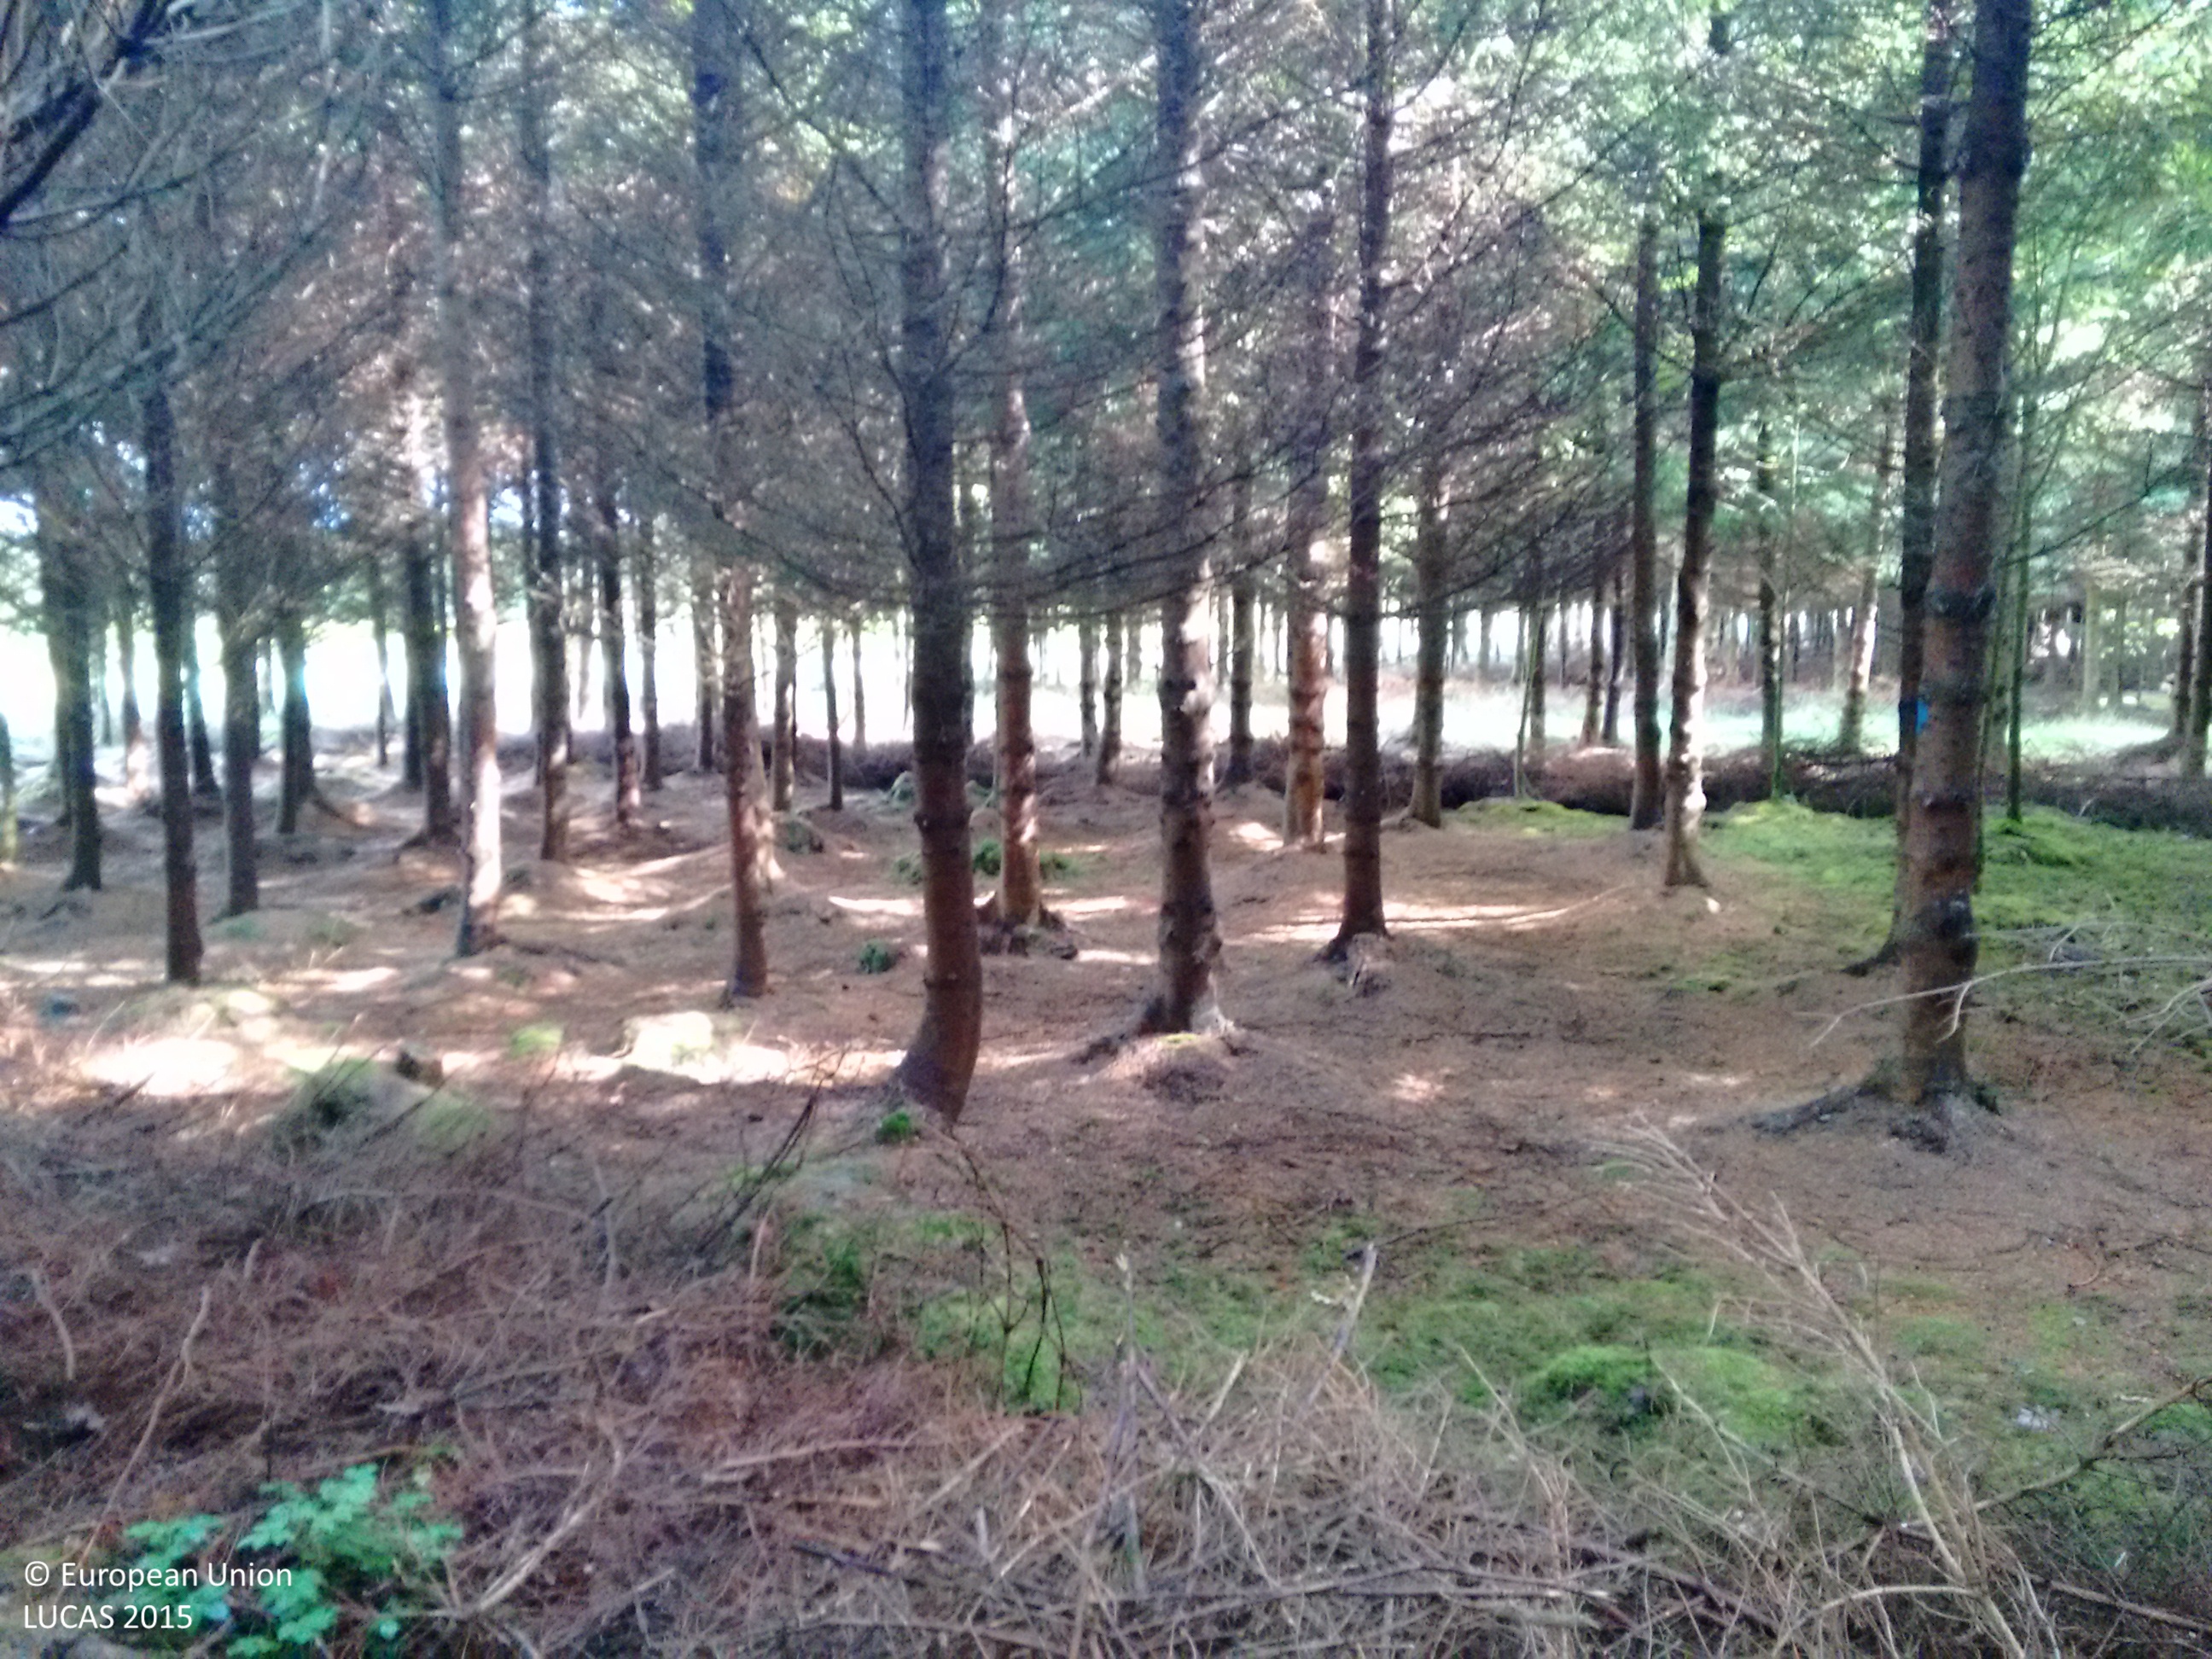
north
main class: Woodland
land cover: Spruce dominated coniferous woodland
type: exotic forest
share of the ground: > 75 %
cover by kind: coniferous forest trees 95 %, lichens and mosses 5 %
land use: Forestry
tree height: > 5 m
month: June
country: IE
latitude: 52.2816
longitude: -7.1058
